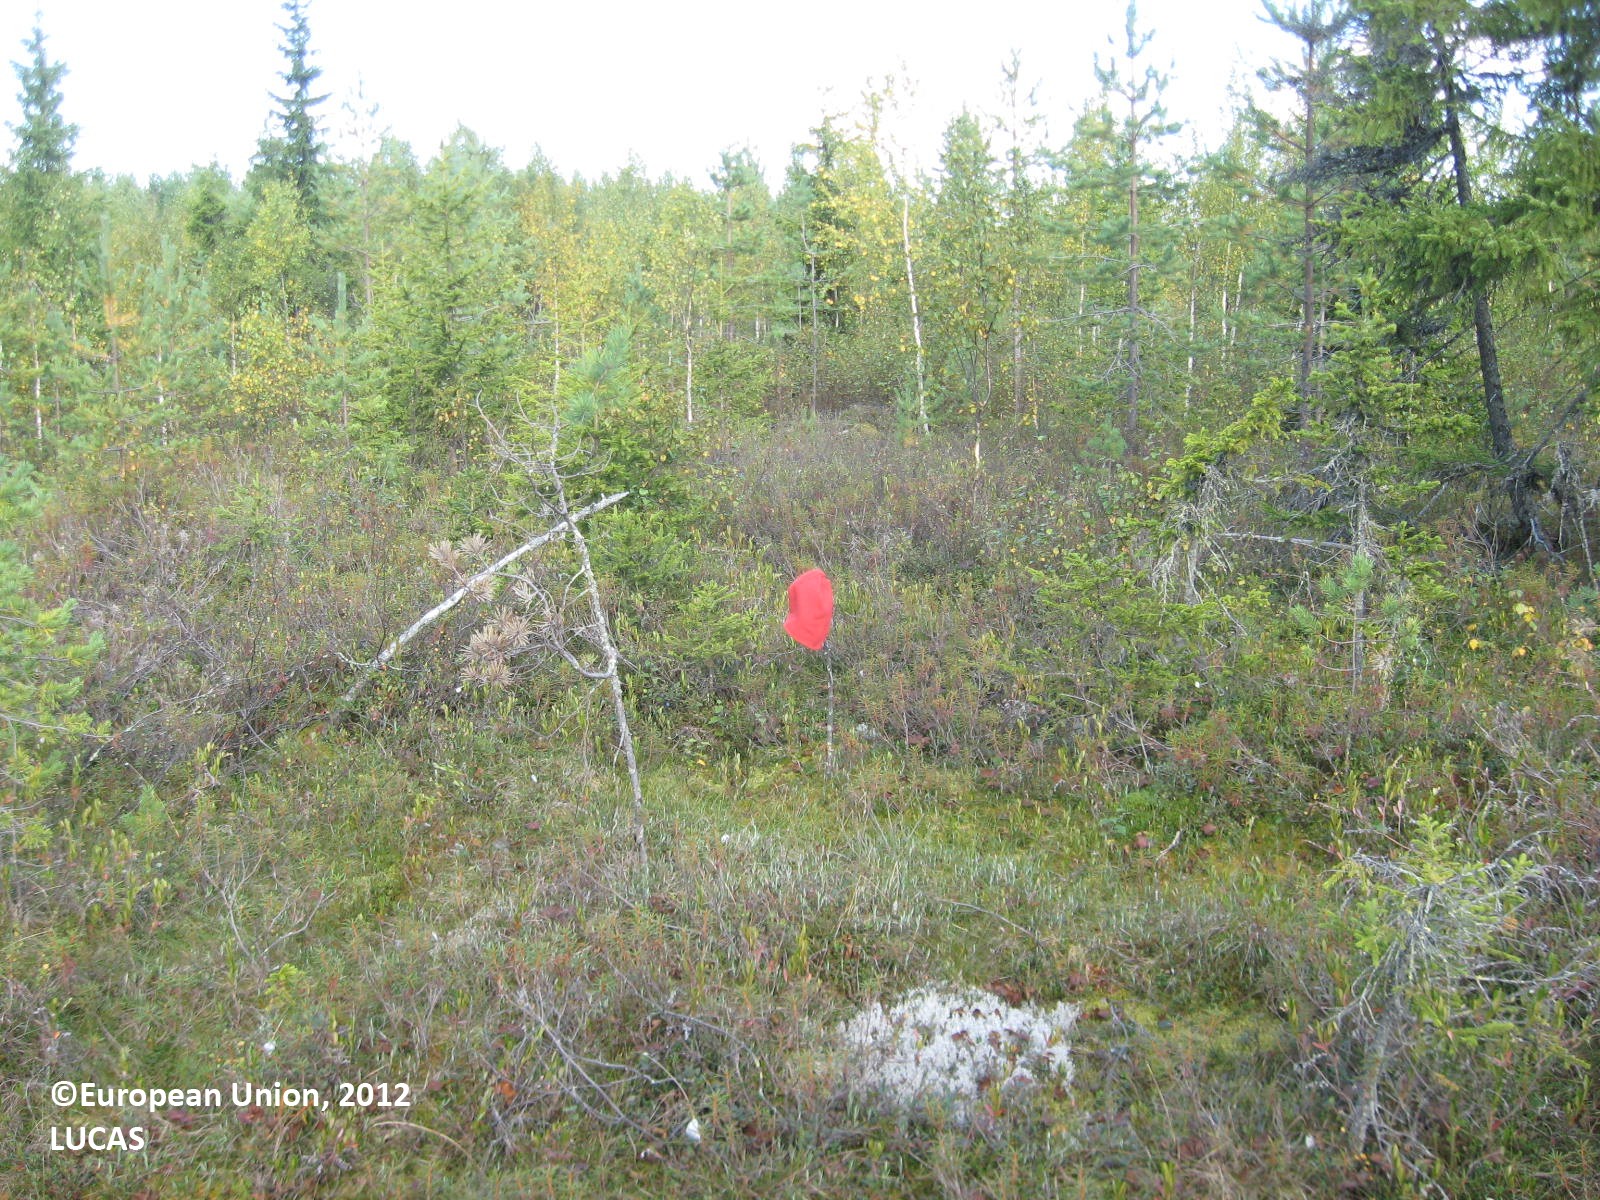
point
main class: Woodland
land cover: Other coniferous woodland
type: boreal forest
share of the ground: 50 - 75 %
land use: Forestry
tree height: < 5 m
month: August
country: FI
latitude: 63.7930
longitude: 29.7373
